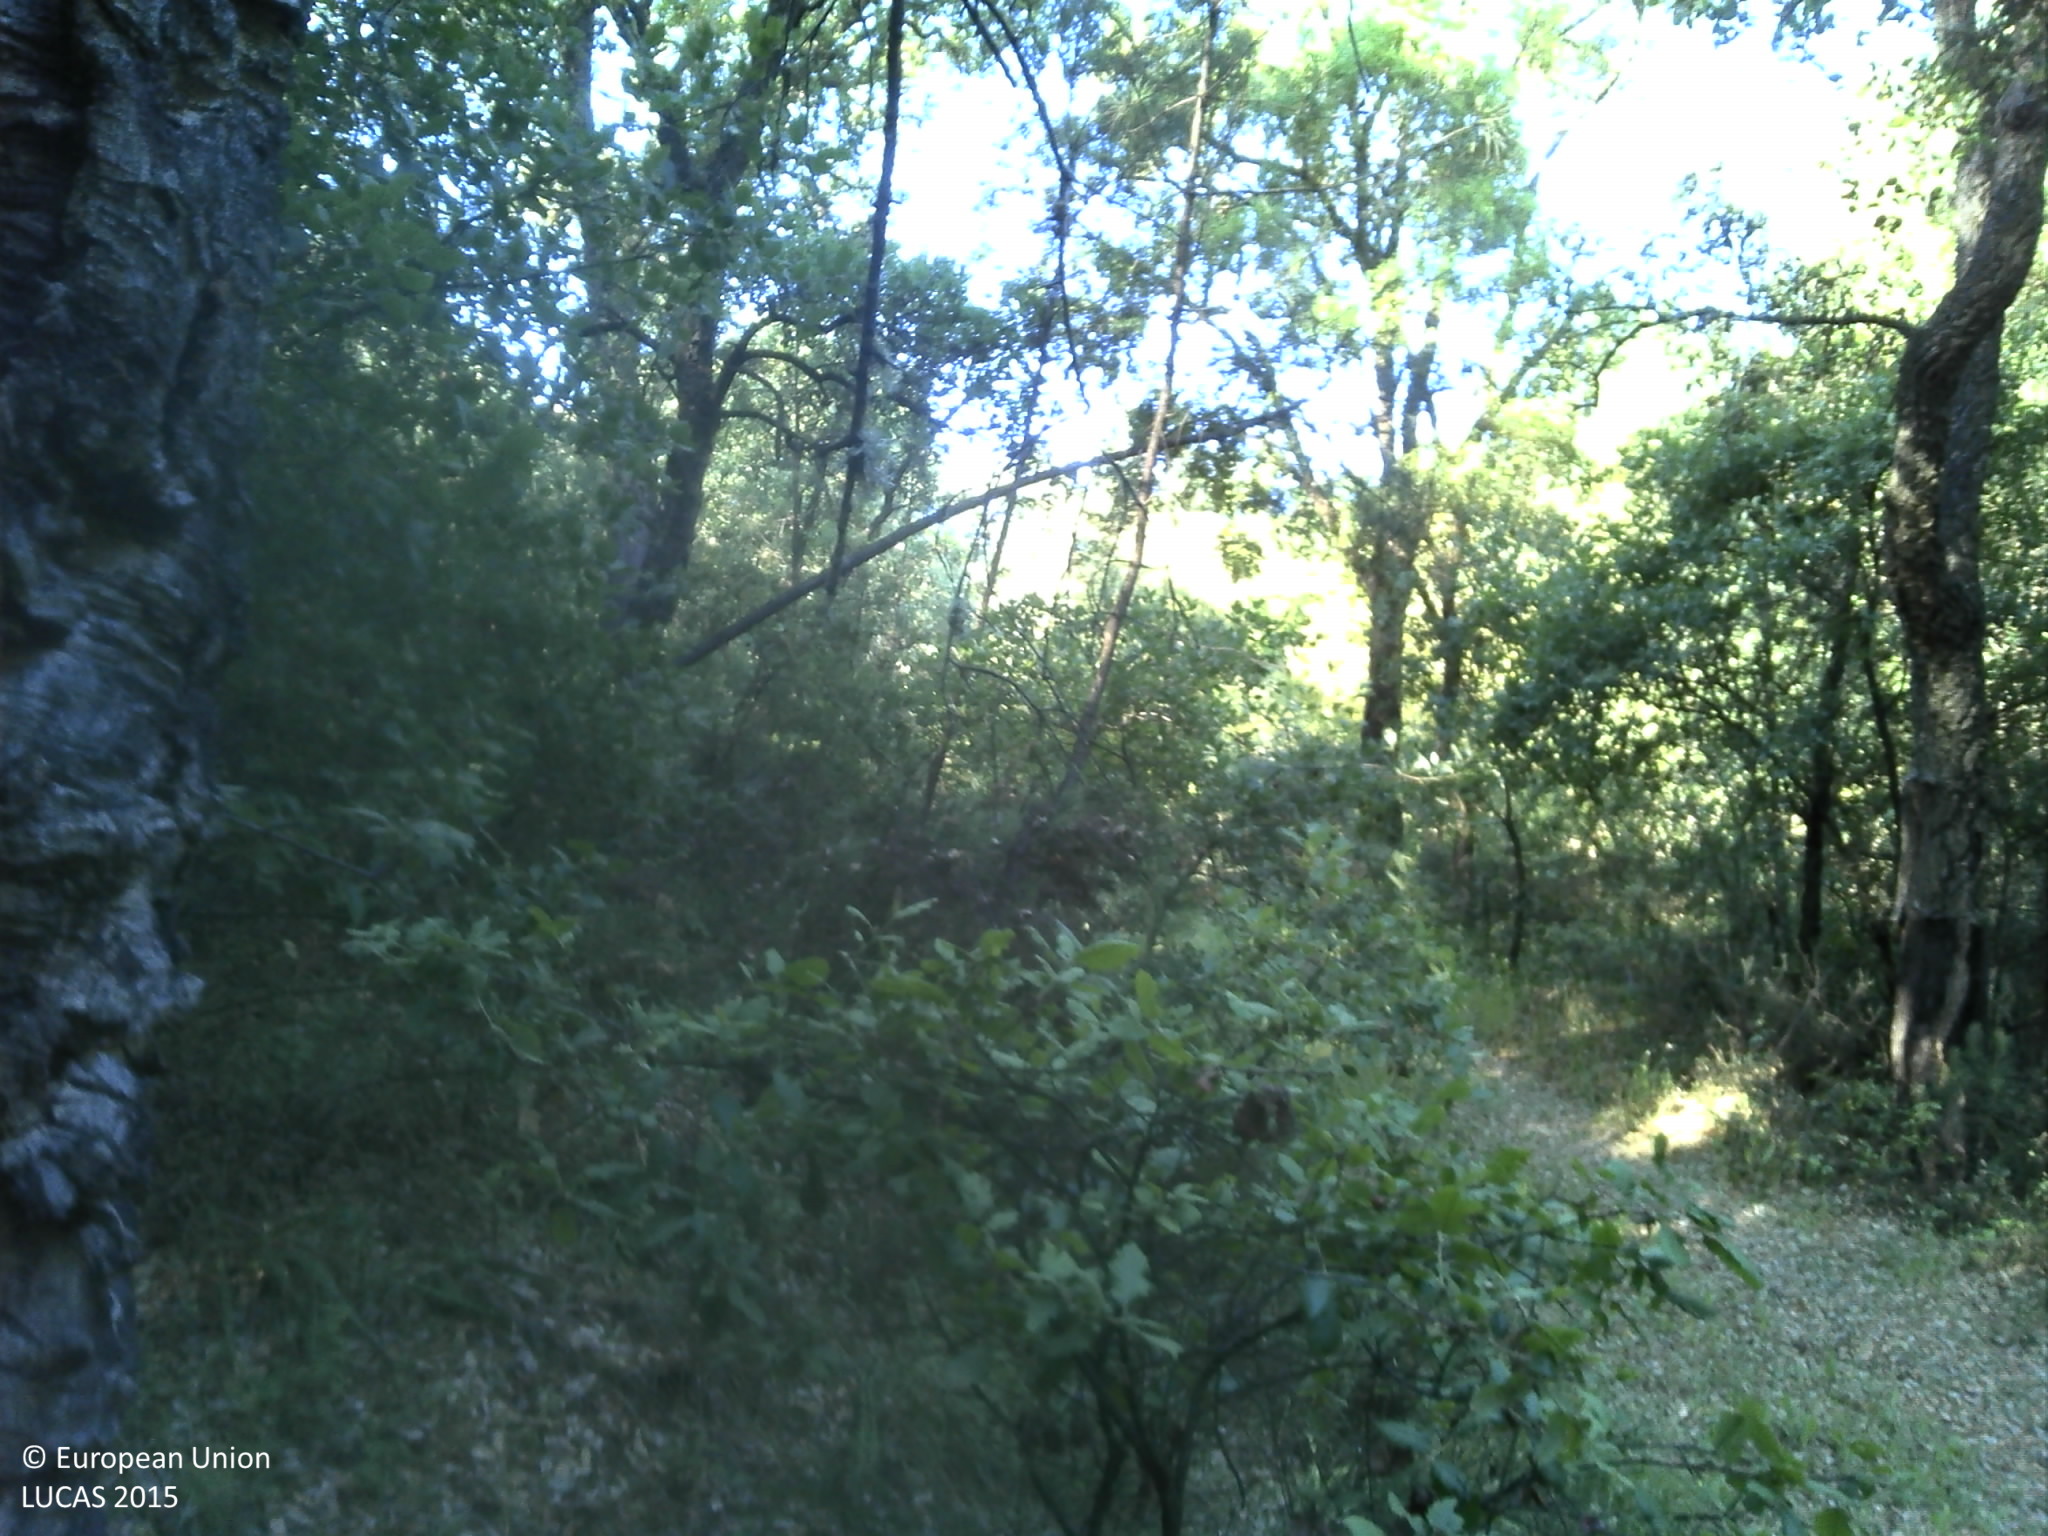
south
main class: Woodland
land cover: Broadleaved woodland
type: mesophytic deciduous forest
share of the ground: 50 - 75 %
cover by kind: broadleaved forest trees 75 %, shrubs 10 %, coniferous forest trees 5 %, herbaceous plants 5 %, unconsolidated bare surface 5 %
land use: Forestry
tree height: > 5 m
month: May
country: PT
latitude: 39.4674
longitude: -8.3278
